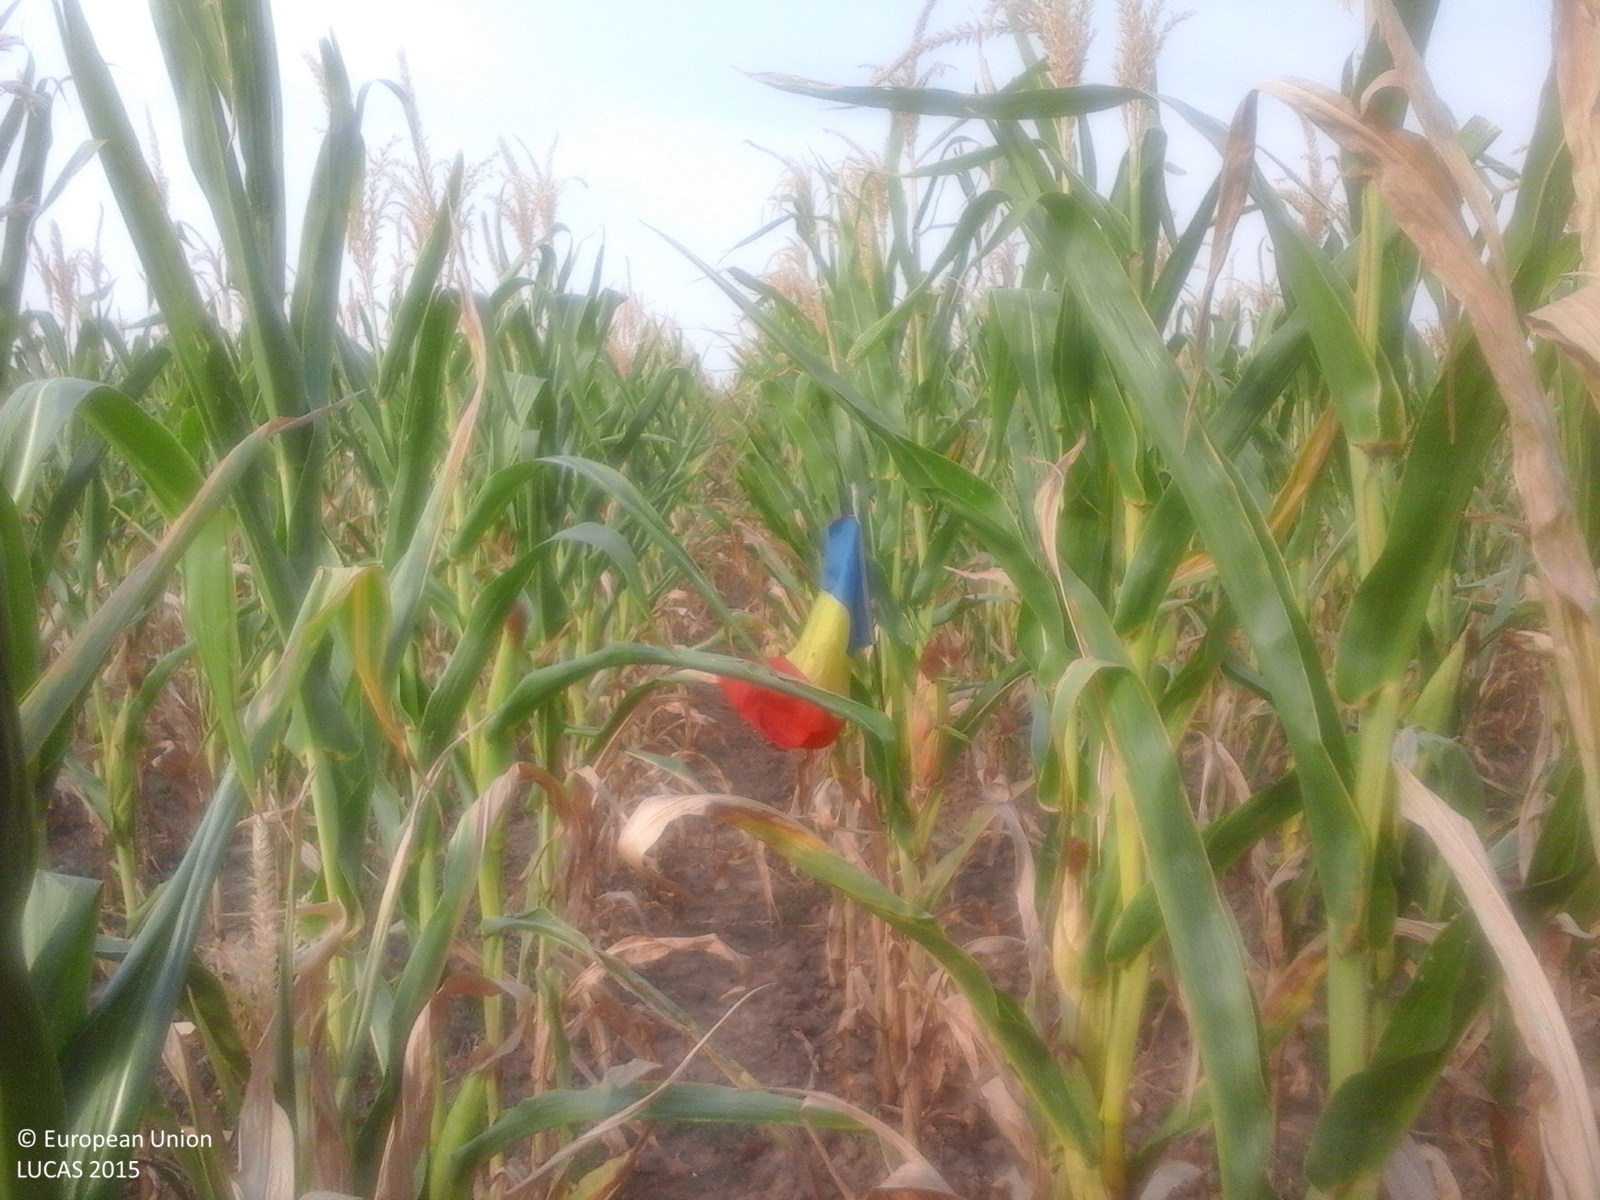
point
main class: Cropland
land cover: Maize
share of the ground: > 75 %
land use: Agriculture (excluding fallow land and kitchen gardens)
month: August
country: RO
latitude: 44.2417
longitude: 22.6987
